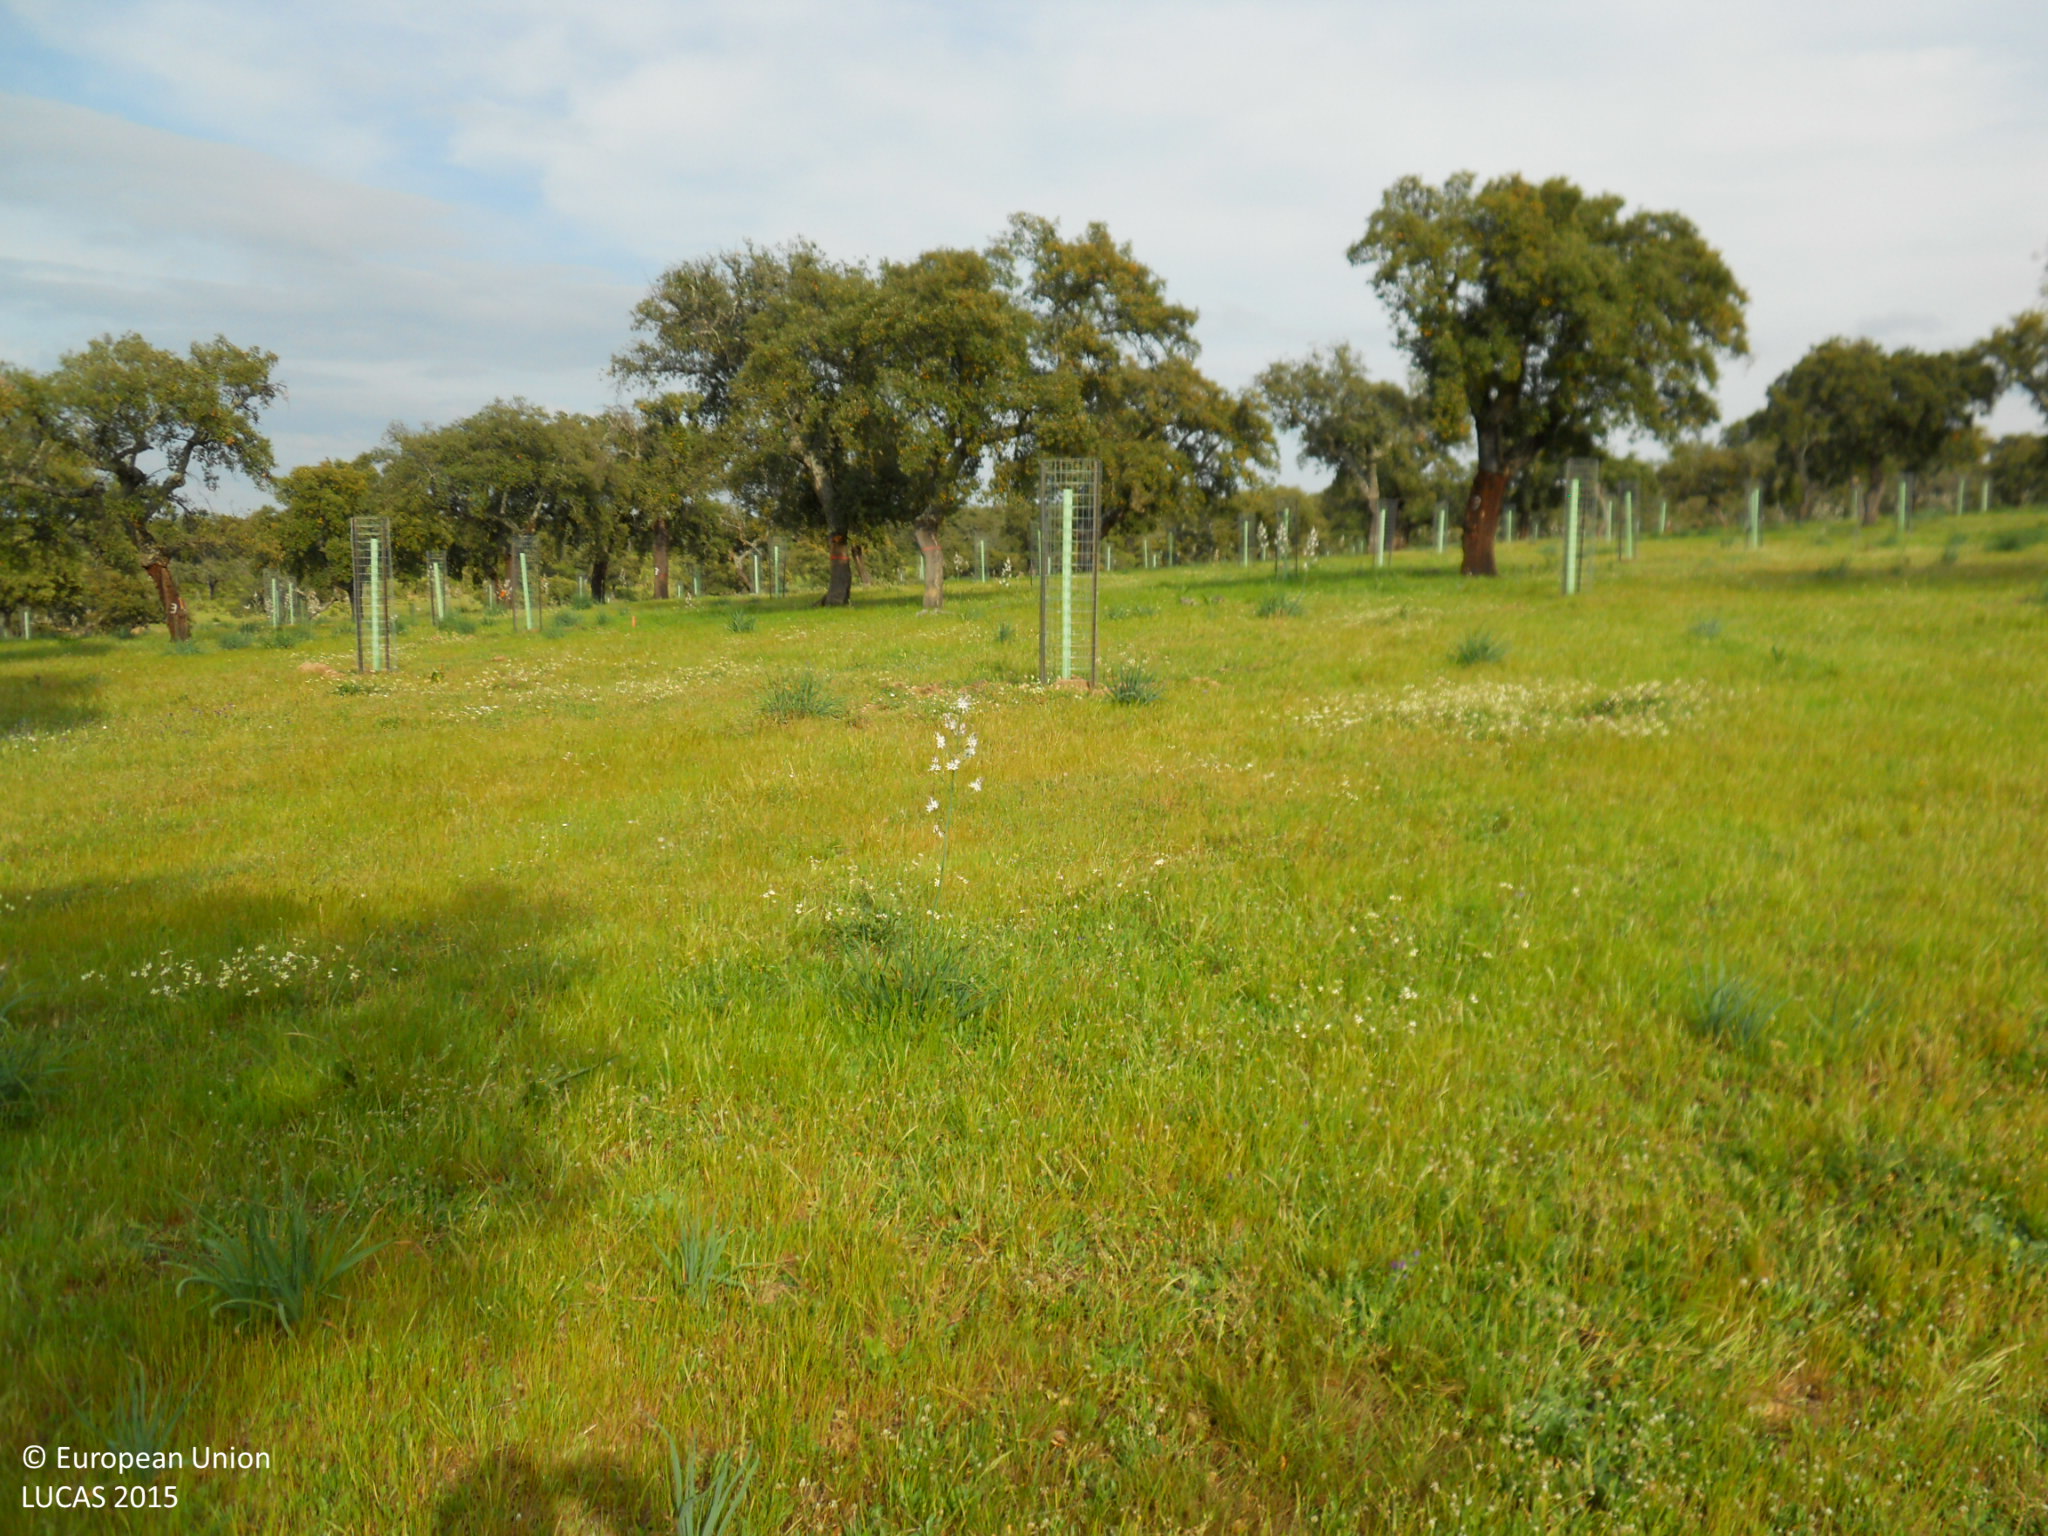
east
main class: Woodland
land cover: Broadleaved woodland
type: broadleaved evergreen forest
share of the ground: 10 - 25 %
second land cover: Grassland without tree/shrub cover
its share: > 75 %
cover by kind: herbaceous plants 80 %, broadleaved forest trees 20 %
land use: Forestry
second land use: Agriculture (excluding fallow land and kitchen gardens)
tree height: > 5 m
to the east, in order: Broadleaved woodland; Grassland without tree/shrub cover; Fences; Dry stone walls; Broadleaved woodland
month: April
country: ES
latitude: 39.1979
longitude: -6.5672
